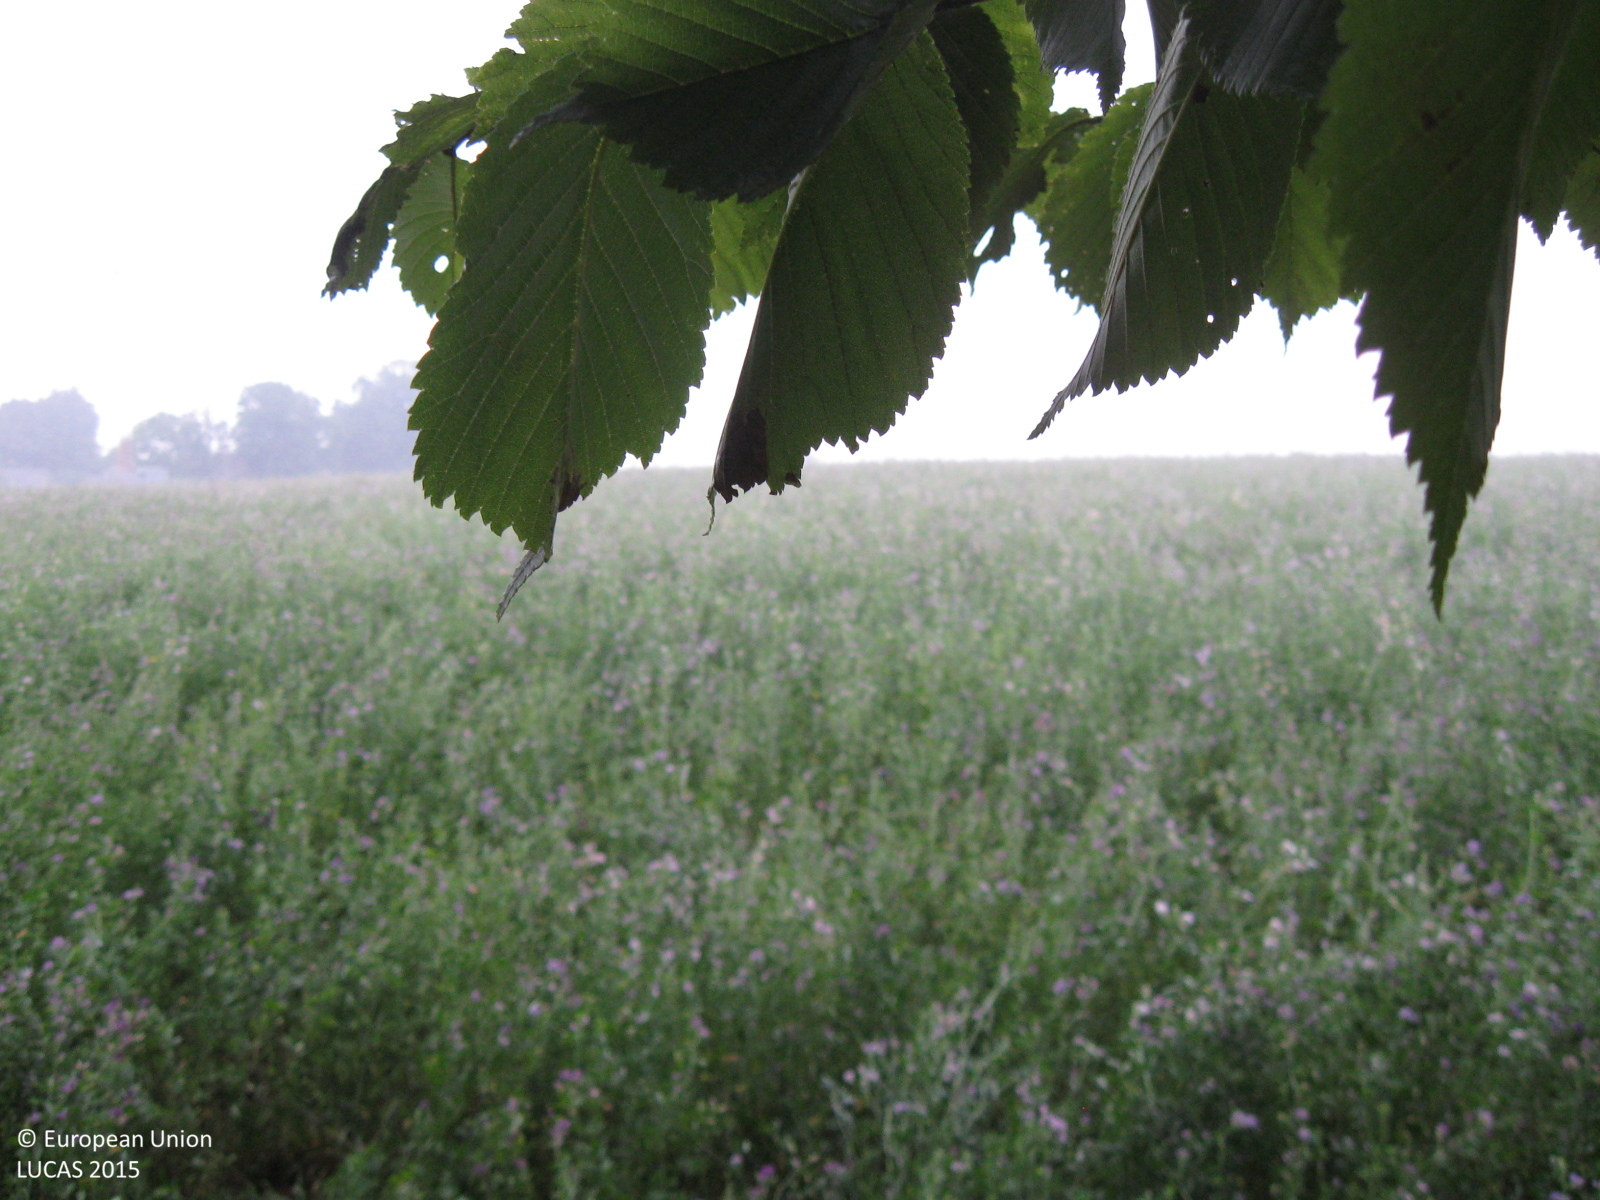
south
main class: Woodland
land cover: Broadleaved woodland
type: non-riverine alder, birch or aspen forest
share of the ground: > 75 %
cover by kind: broadleaved forest trees 95 %, herbaceous plants 5 %
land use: Forestry
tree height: > 5 m
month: September
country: LT
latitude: 55.0935
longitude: 23.0940
